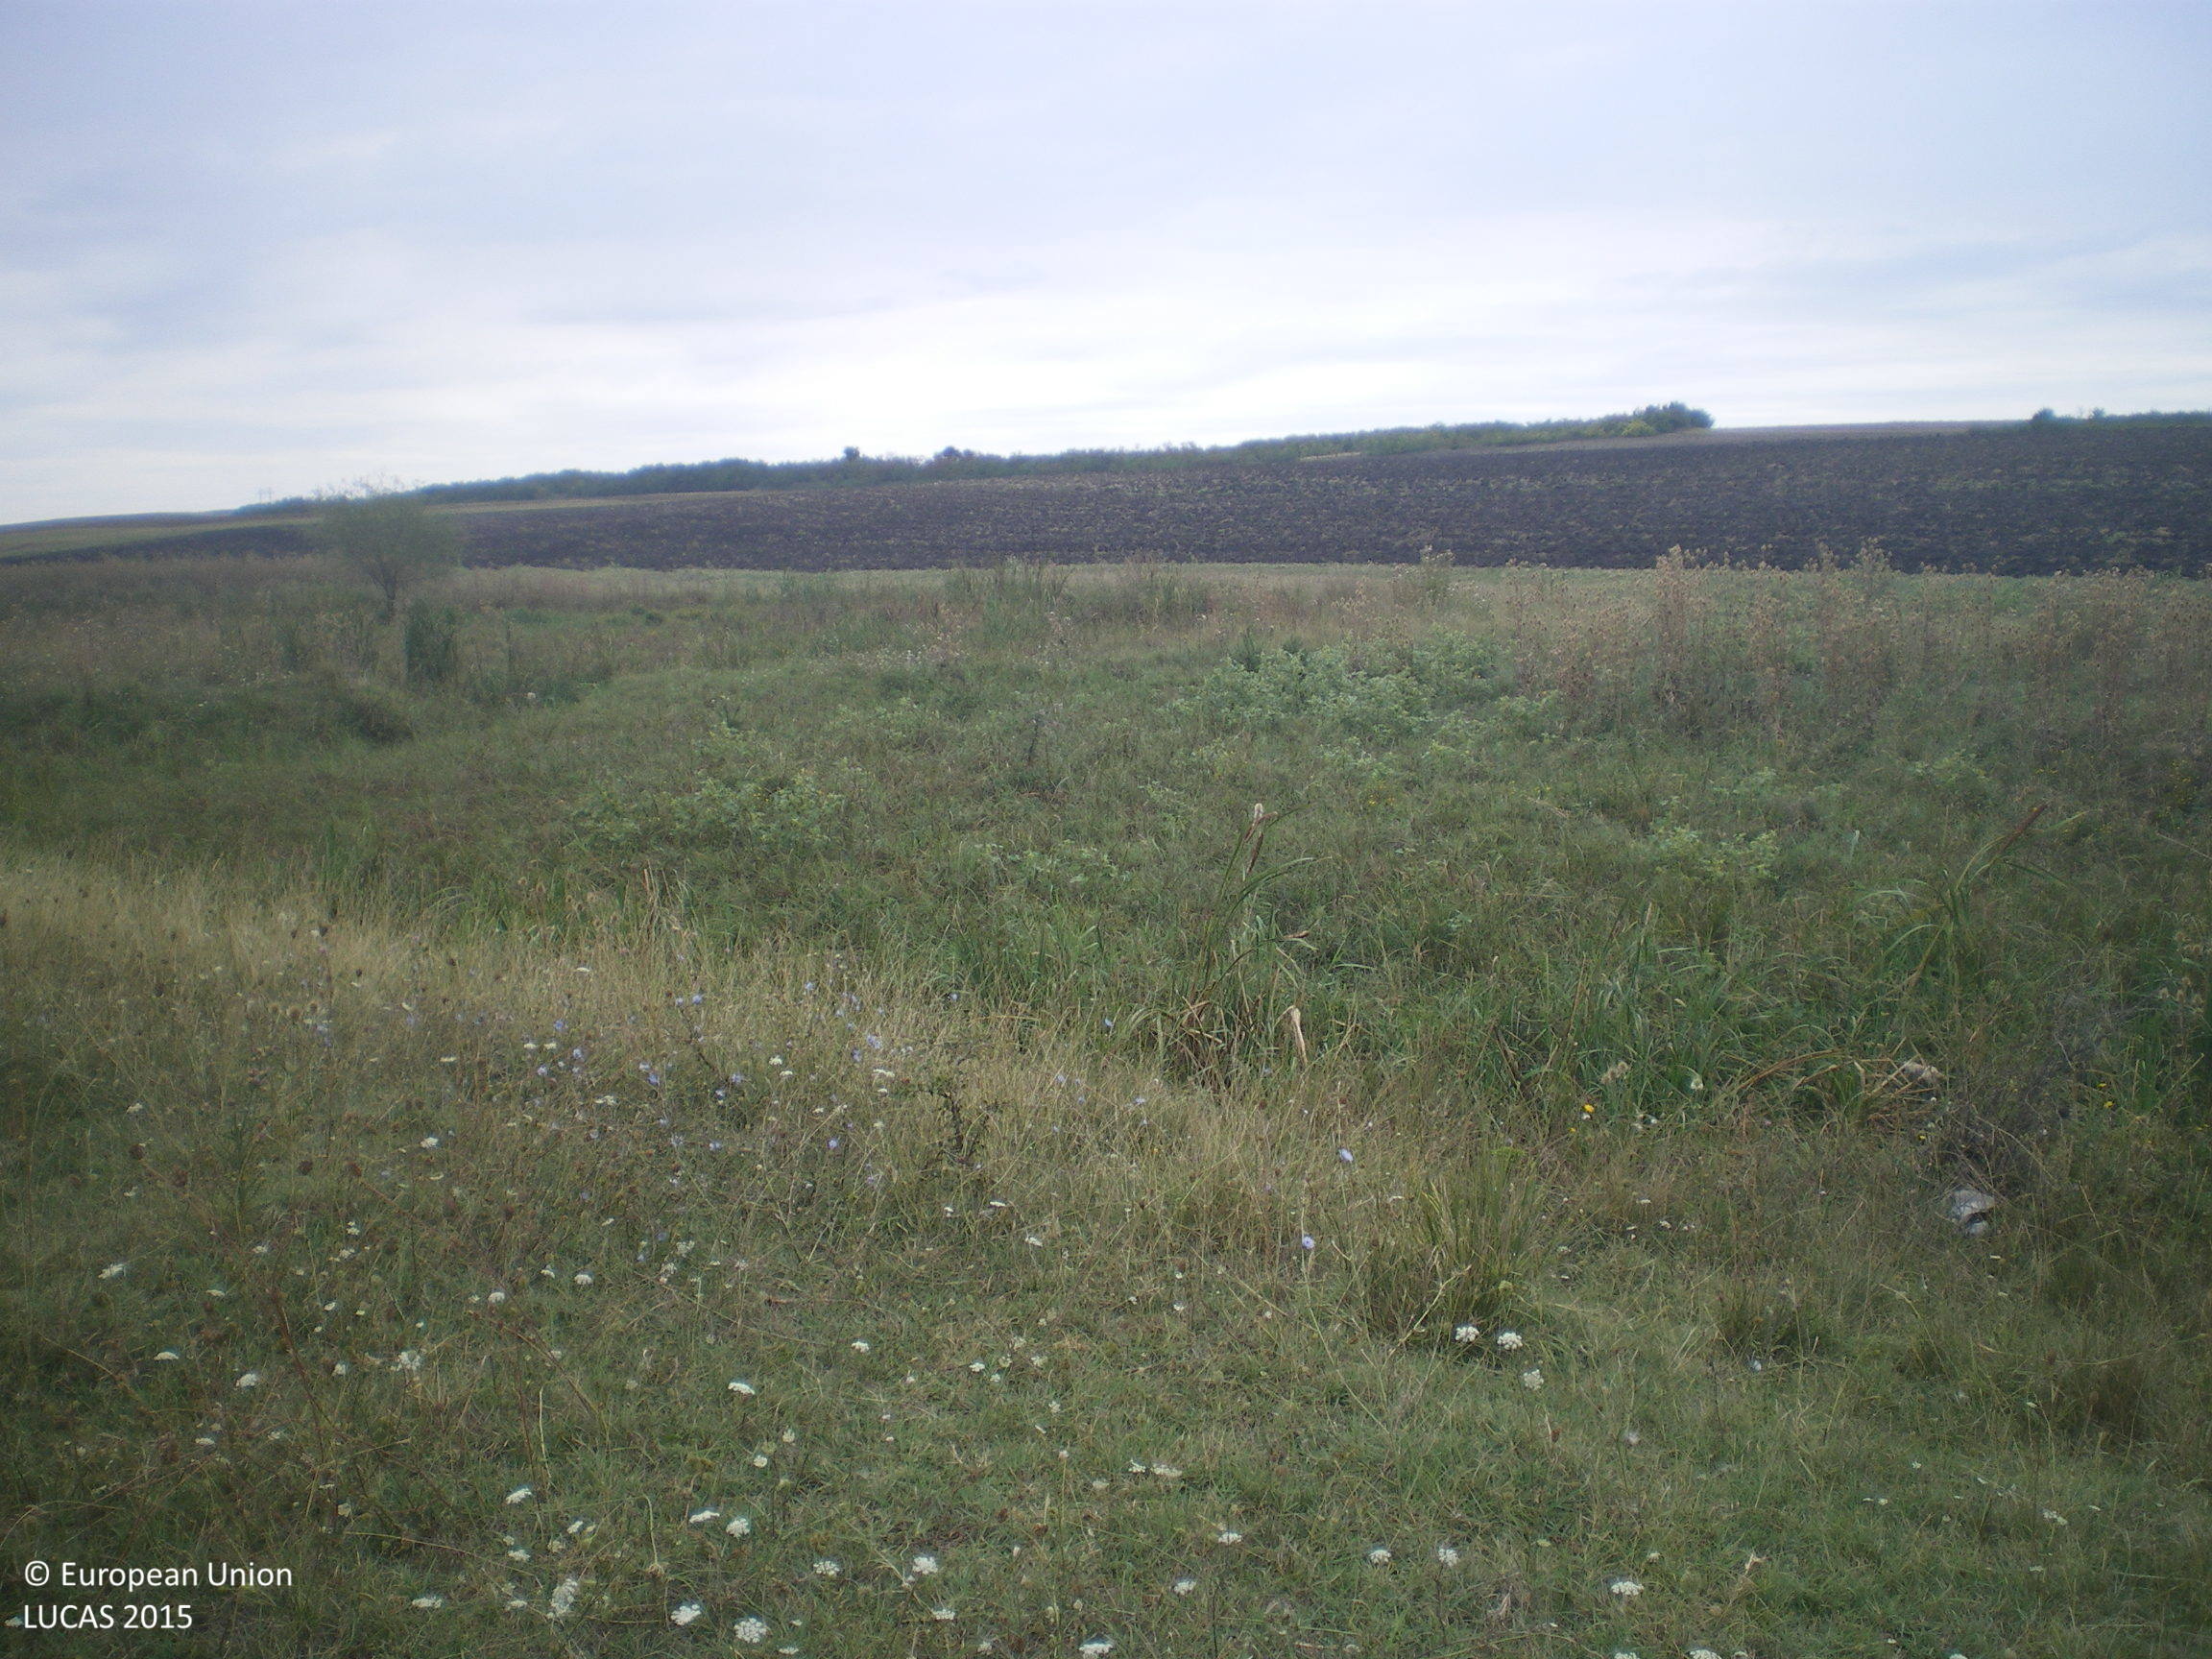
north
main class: Grassland
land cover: Grassland without tree/shrub cover
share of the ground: > 75 %
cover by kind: herbaceous plants 100 %
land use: Agriculture (excluding fallow land and kitchen gardens)
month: September
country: BG
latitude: 42.2356
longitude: 25.8885
